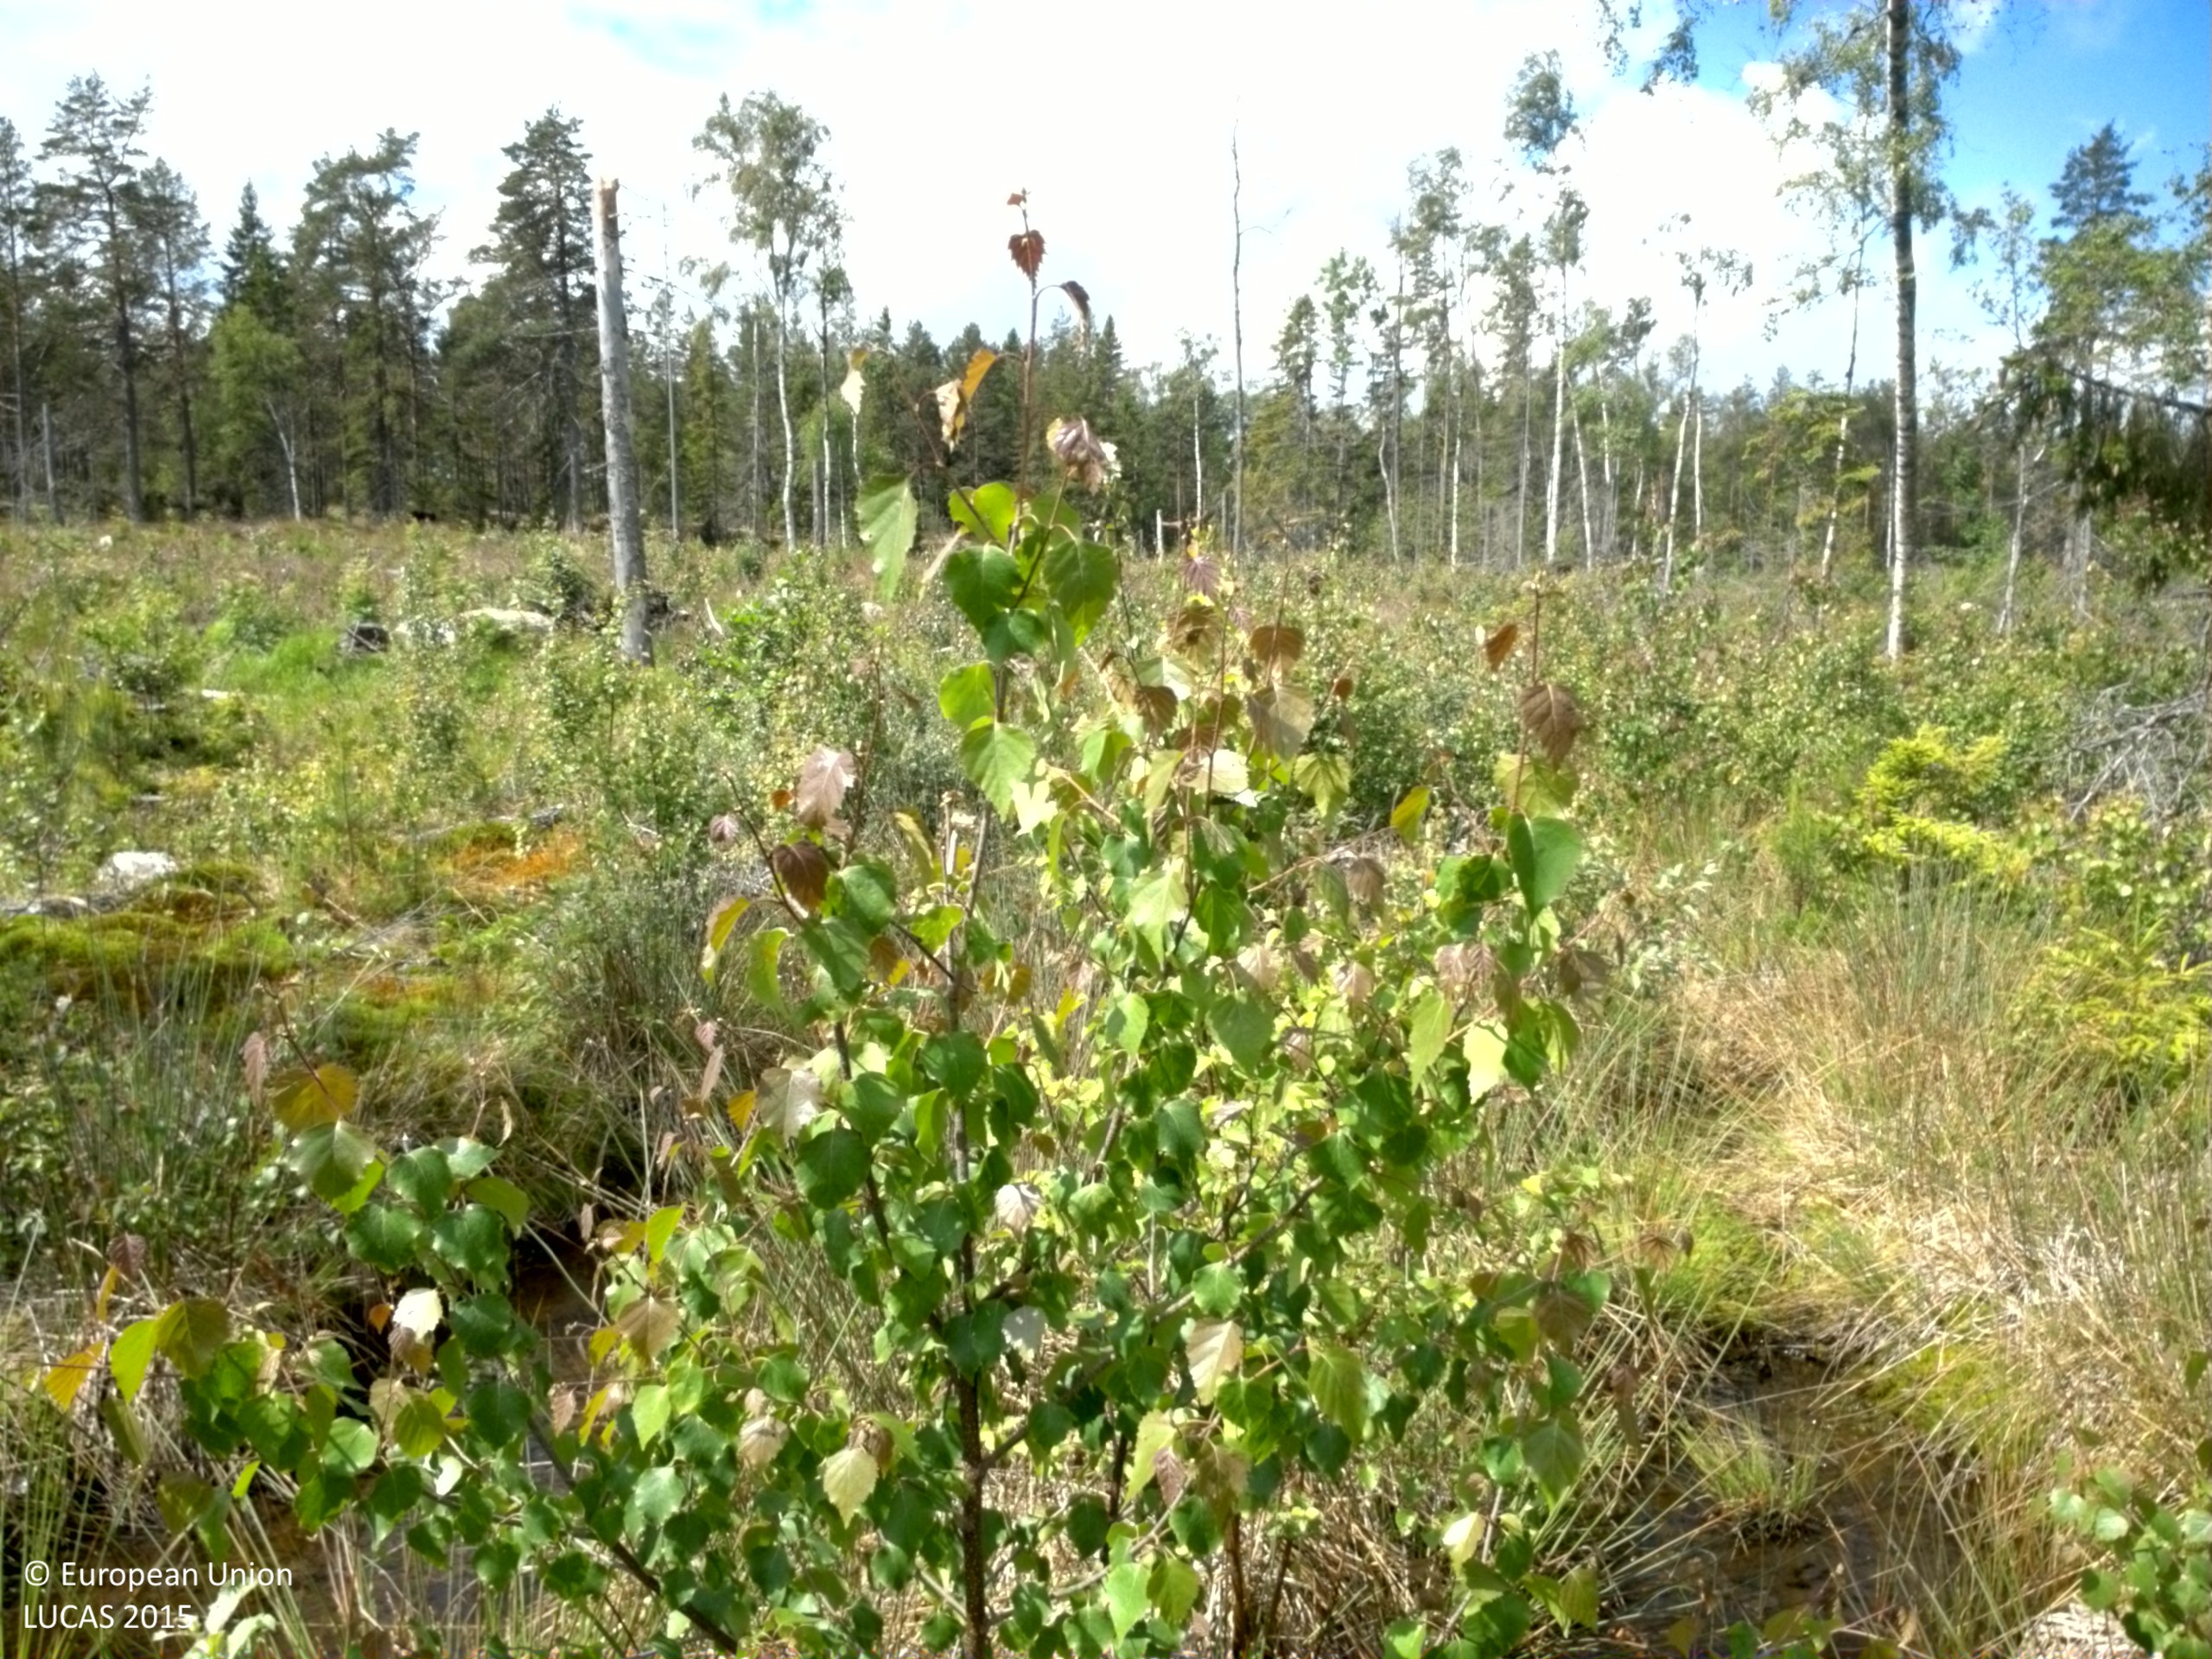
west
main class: Woodland
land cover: Broadleaved woodland
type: boreal forest
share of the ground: 25 - 50 %
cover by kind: herbaceous plants 45 %, broadleaved forest trees 35 %, lichens and mosses 10 %, coniferous forest trees 5 %, shrubs 5 %
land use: Forestry
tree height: < 5 m
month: June
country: SE
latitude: 60.4081
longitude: 17.6347
